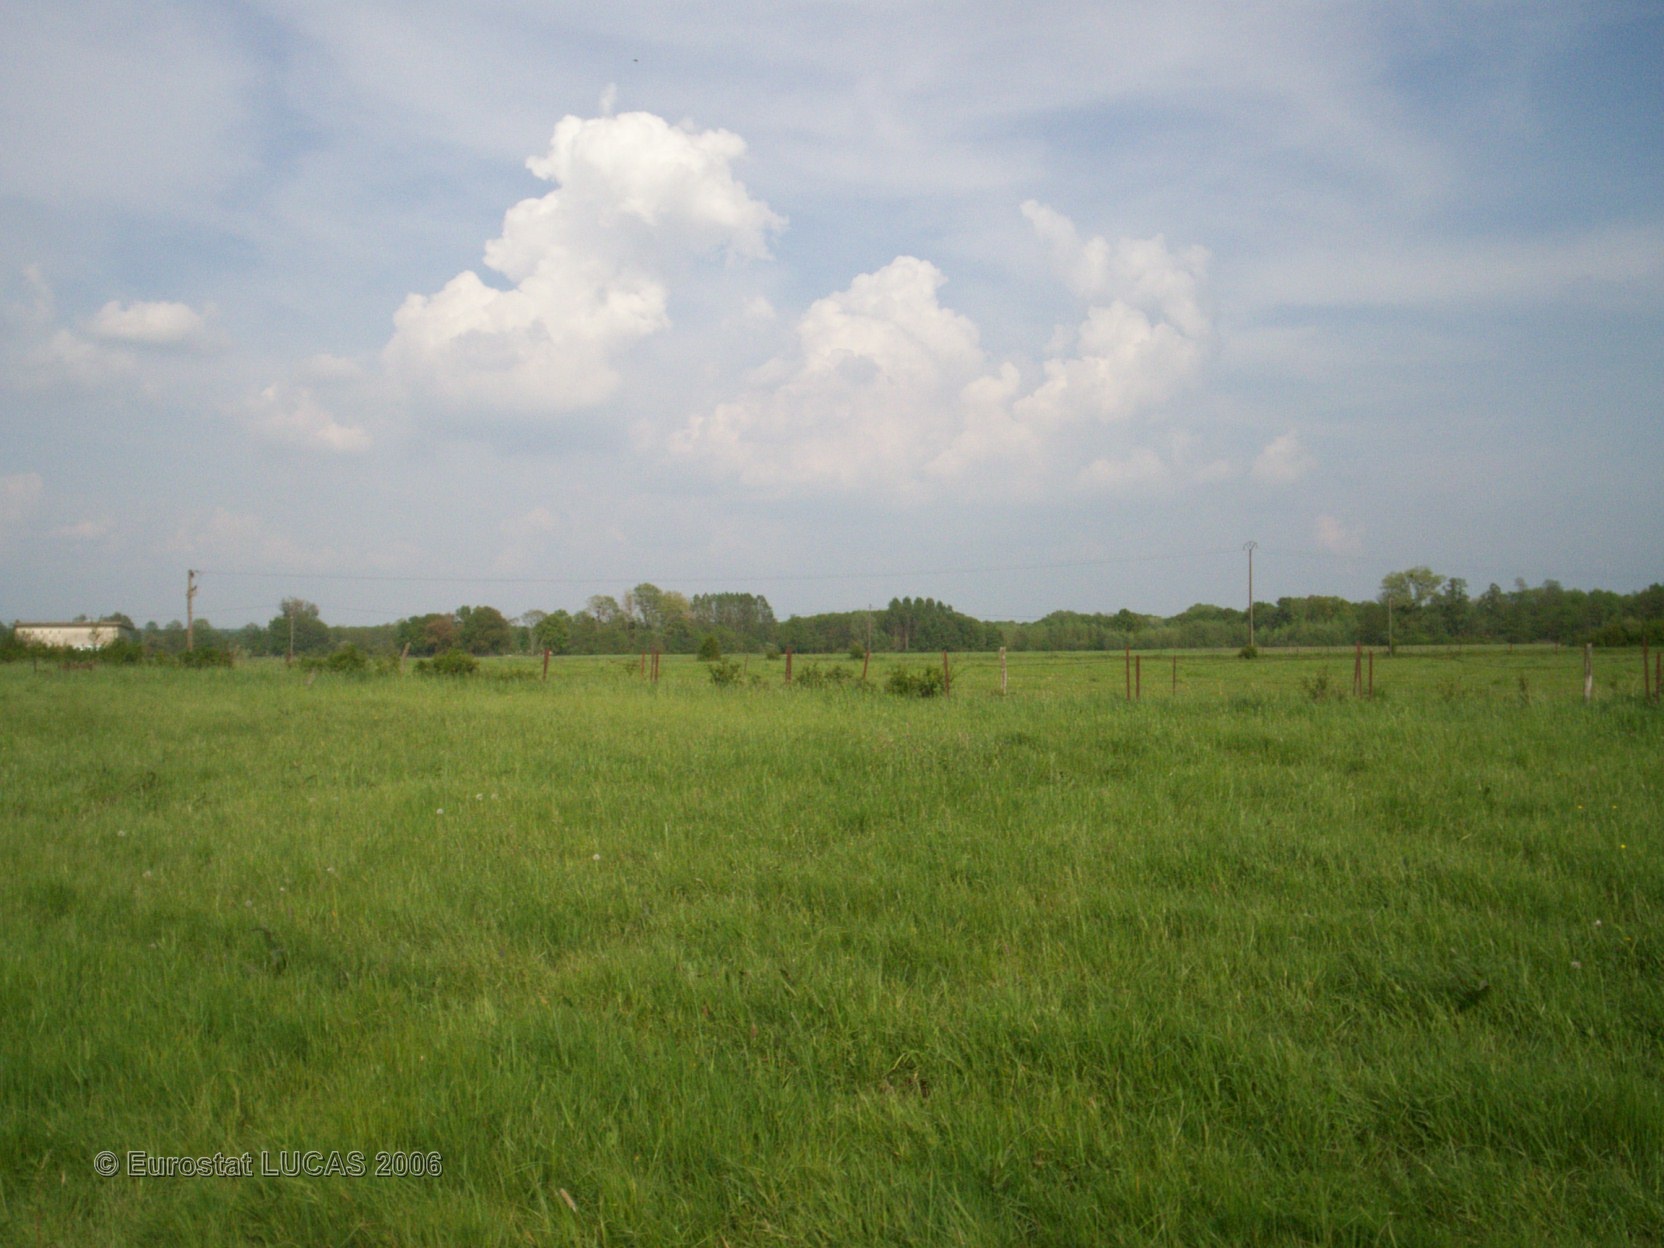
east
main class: Grassland
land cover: Grassland without tree/shrub cover
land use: Agriculture (excluding fallow land and kitchen gardens)
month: May
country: FR
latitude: 49.6108
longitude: 4.3354
